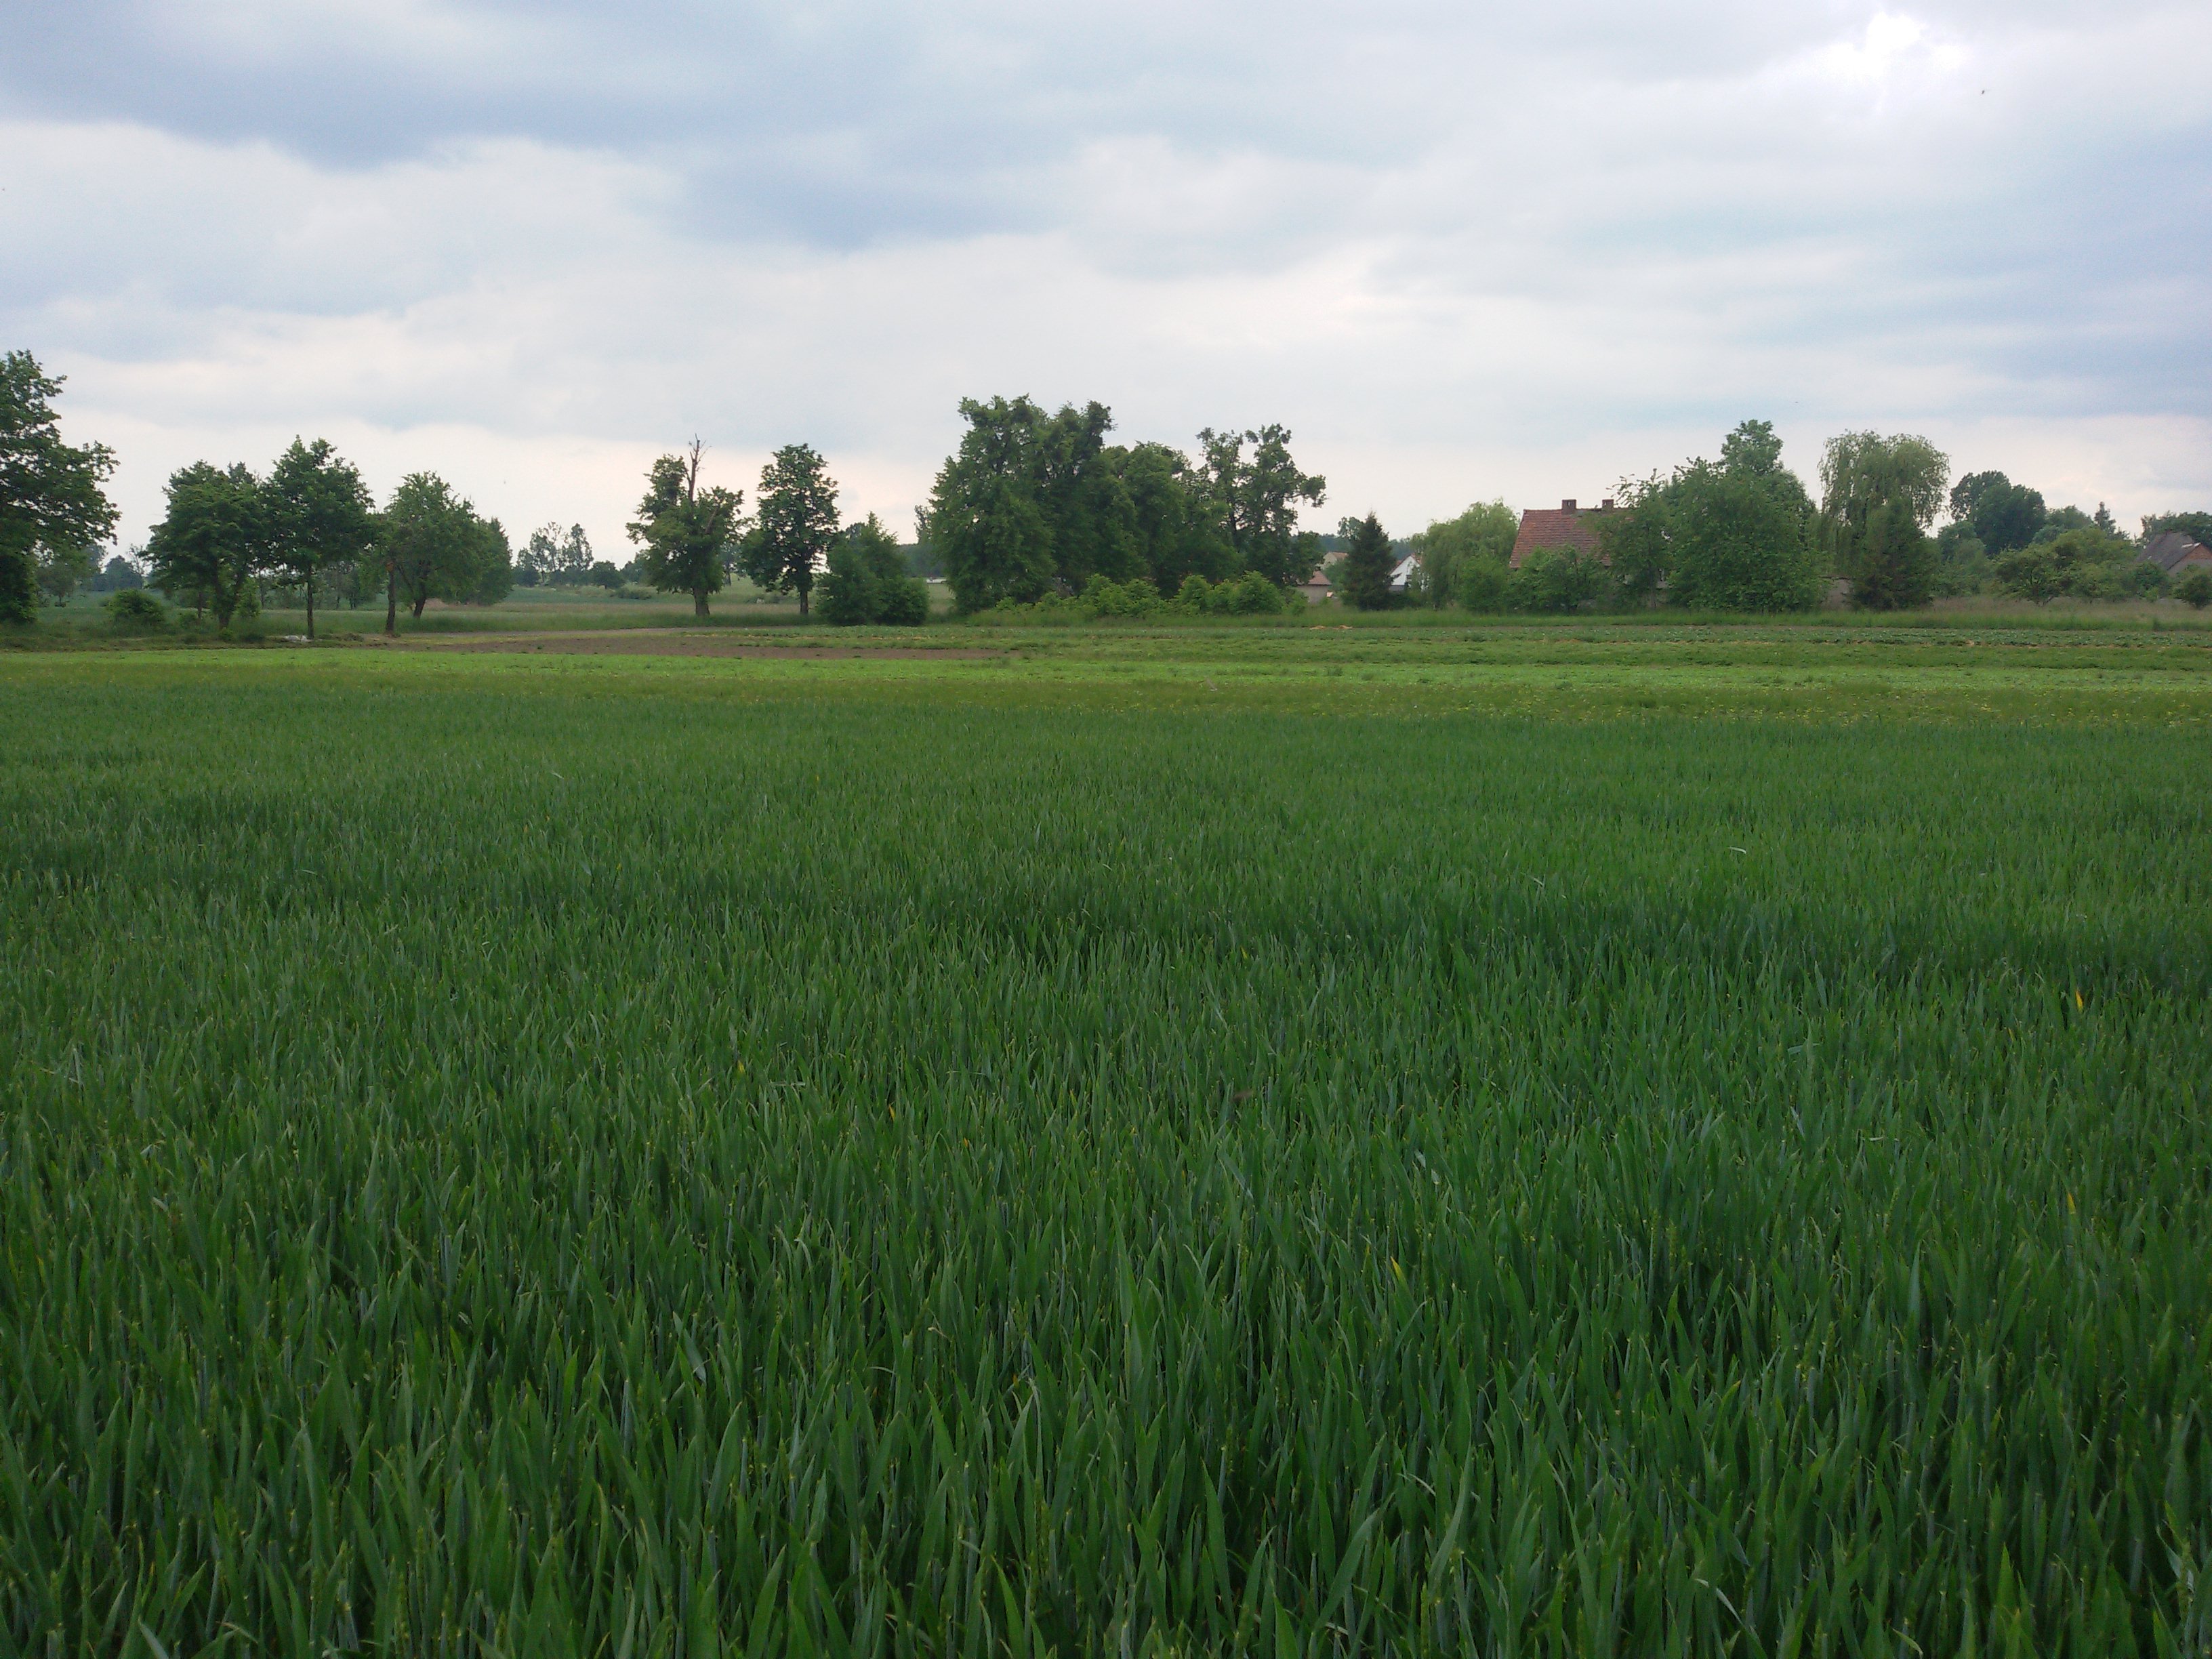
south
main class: Cropland
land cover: Common wheat
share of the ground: > 75 %
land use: Agriculture (excluding fallow land and kitchen gardens)
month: May
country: PL
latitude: 50.6307
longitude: 17.6620
